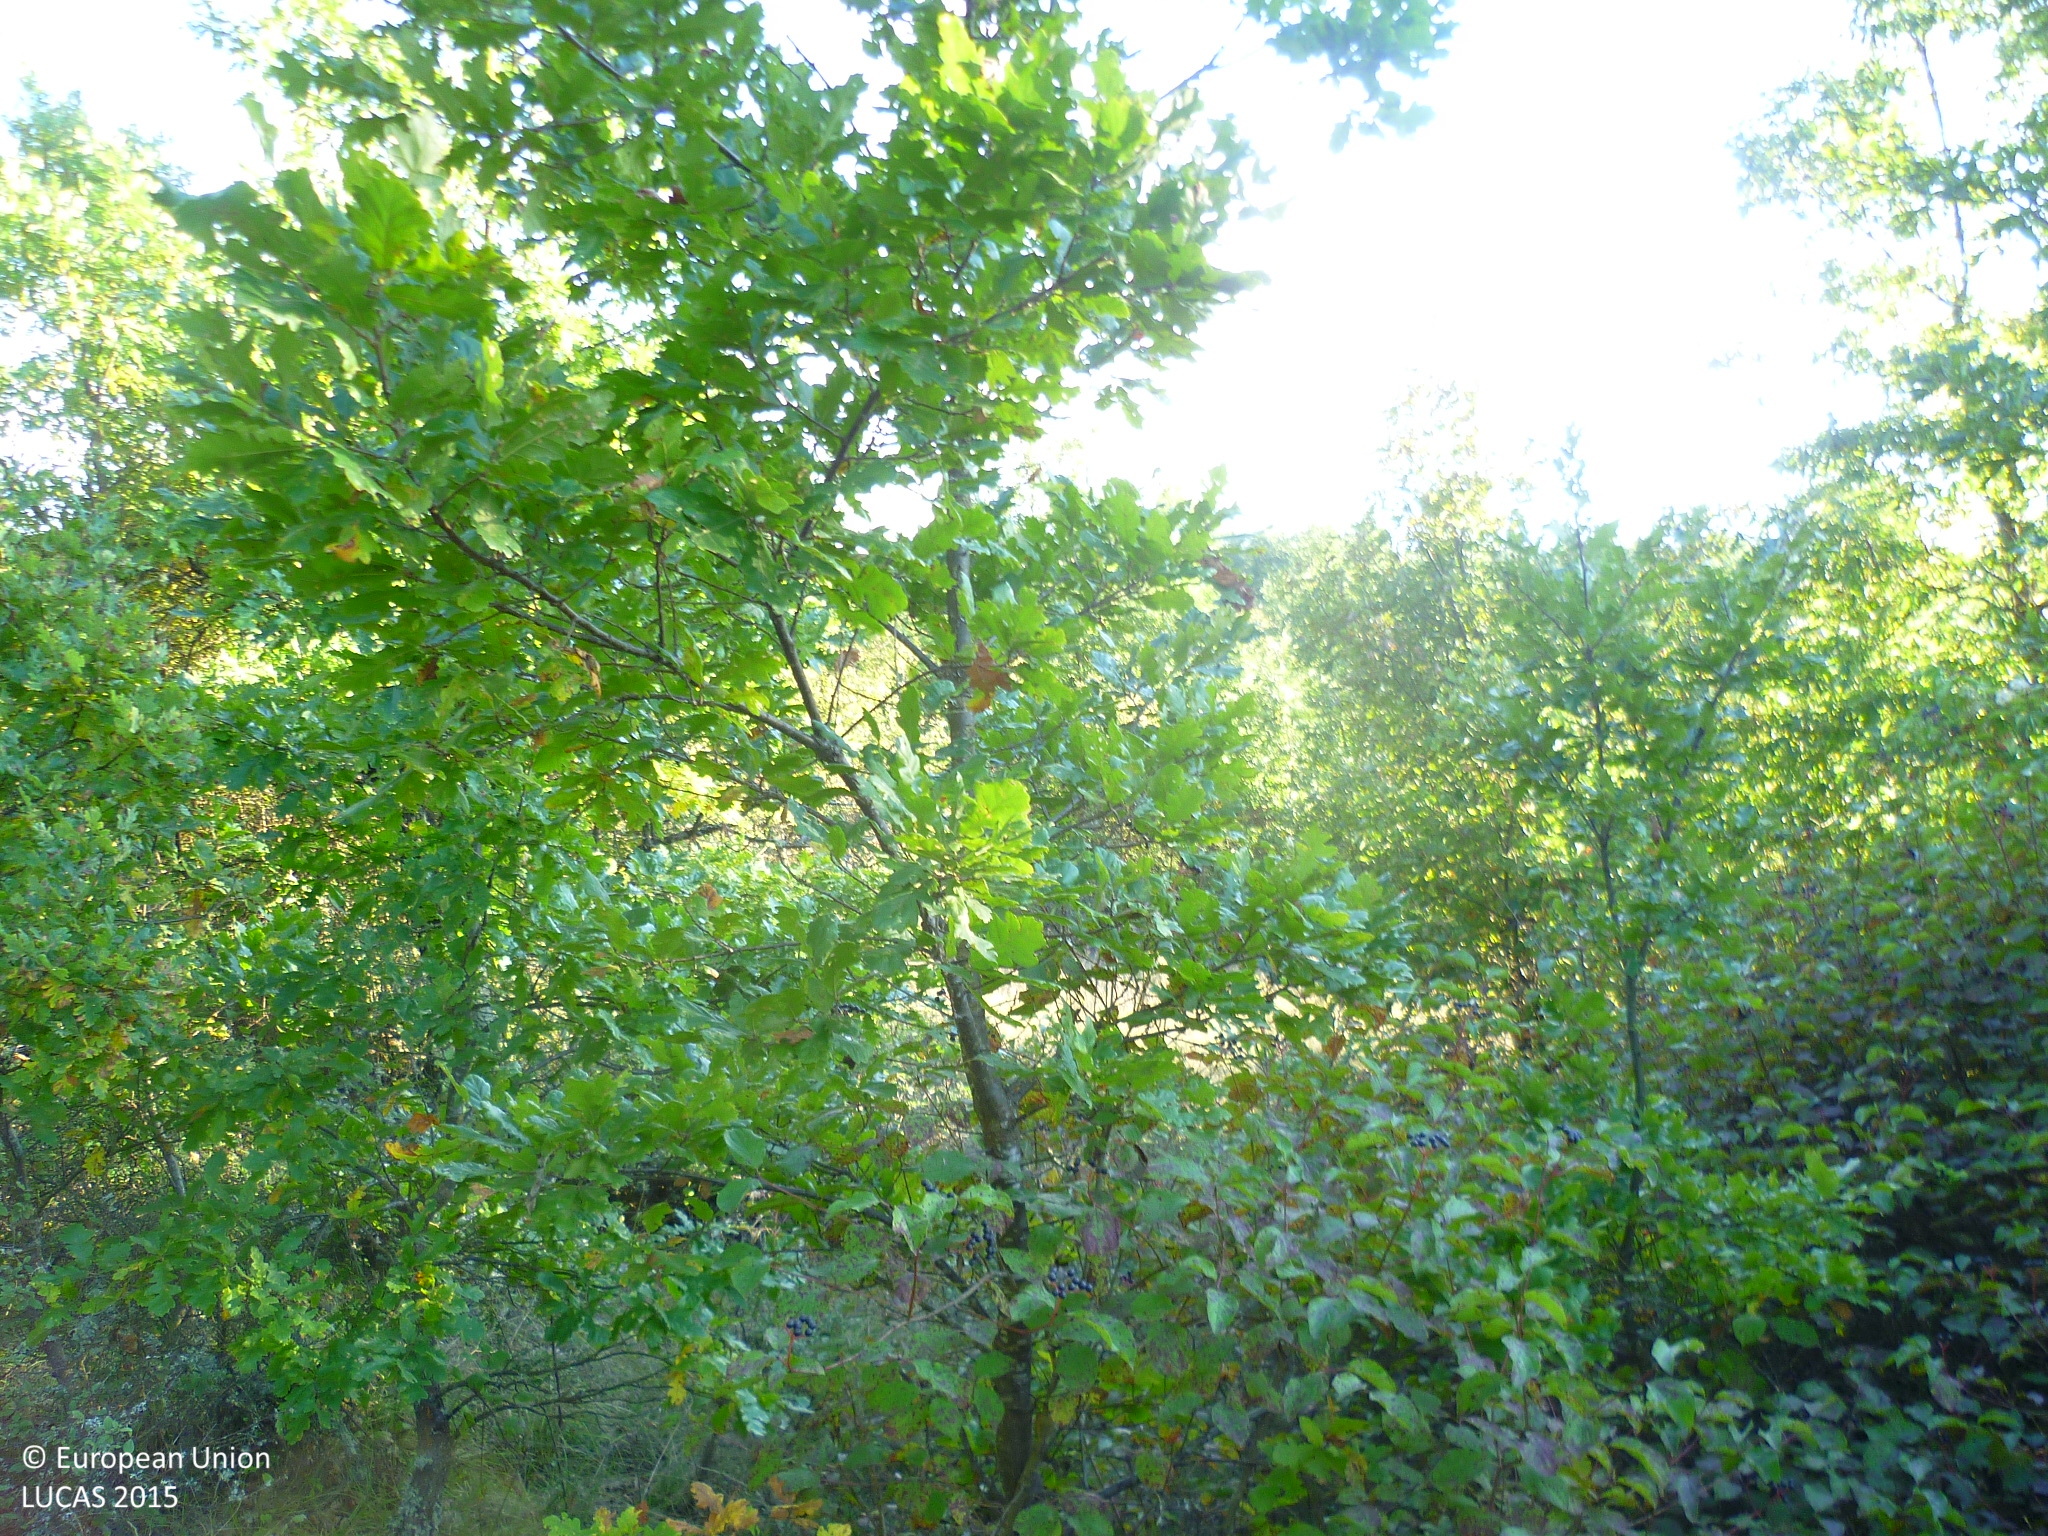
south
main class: Woodland
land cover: Broadleaved woodland
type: mesophytic deciduous forest
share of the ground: 50 - 75 %
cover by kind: broadleaved forest trees 60 %, herbaceous plants 15 %, coniferous forest trees 10 %, shrubs 10 %, unconsolidated bare surface 5 %
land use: Semi-natural and natural areas not in use
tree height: > 5 m
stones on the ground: 25 - 50 %
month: October
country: BG
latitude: 43.0414
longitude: 22.9580
